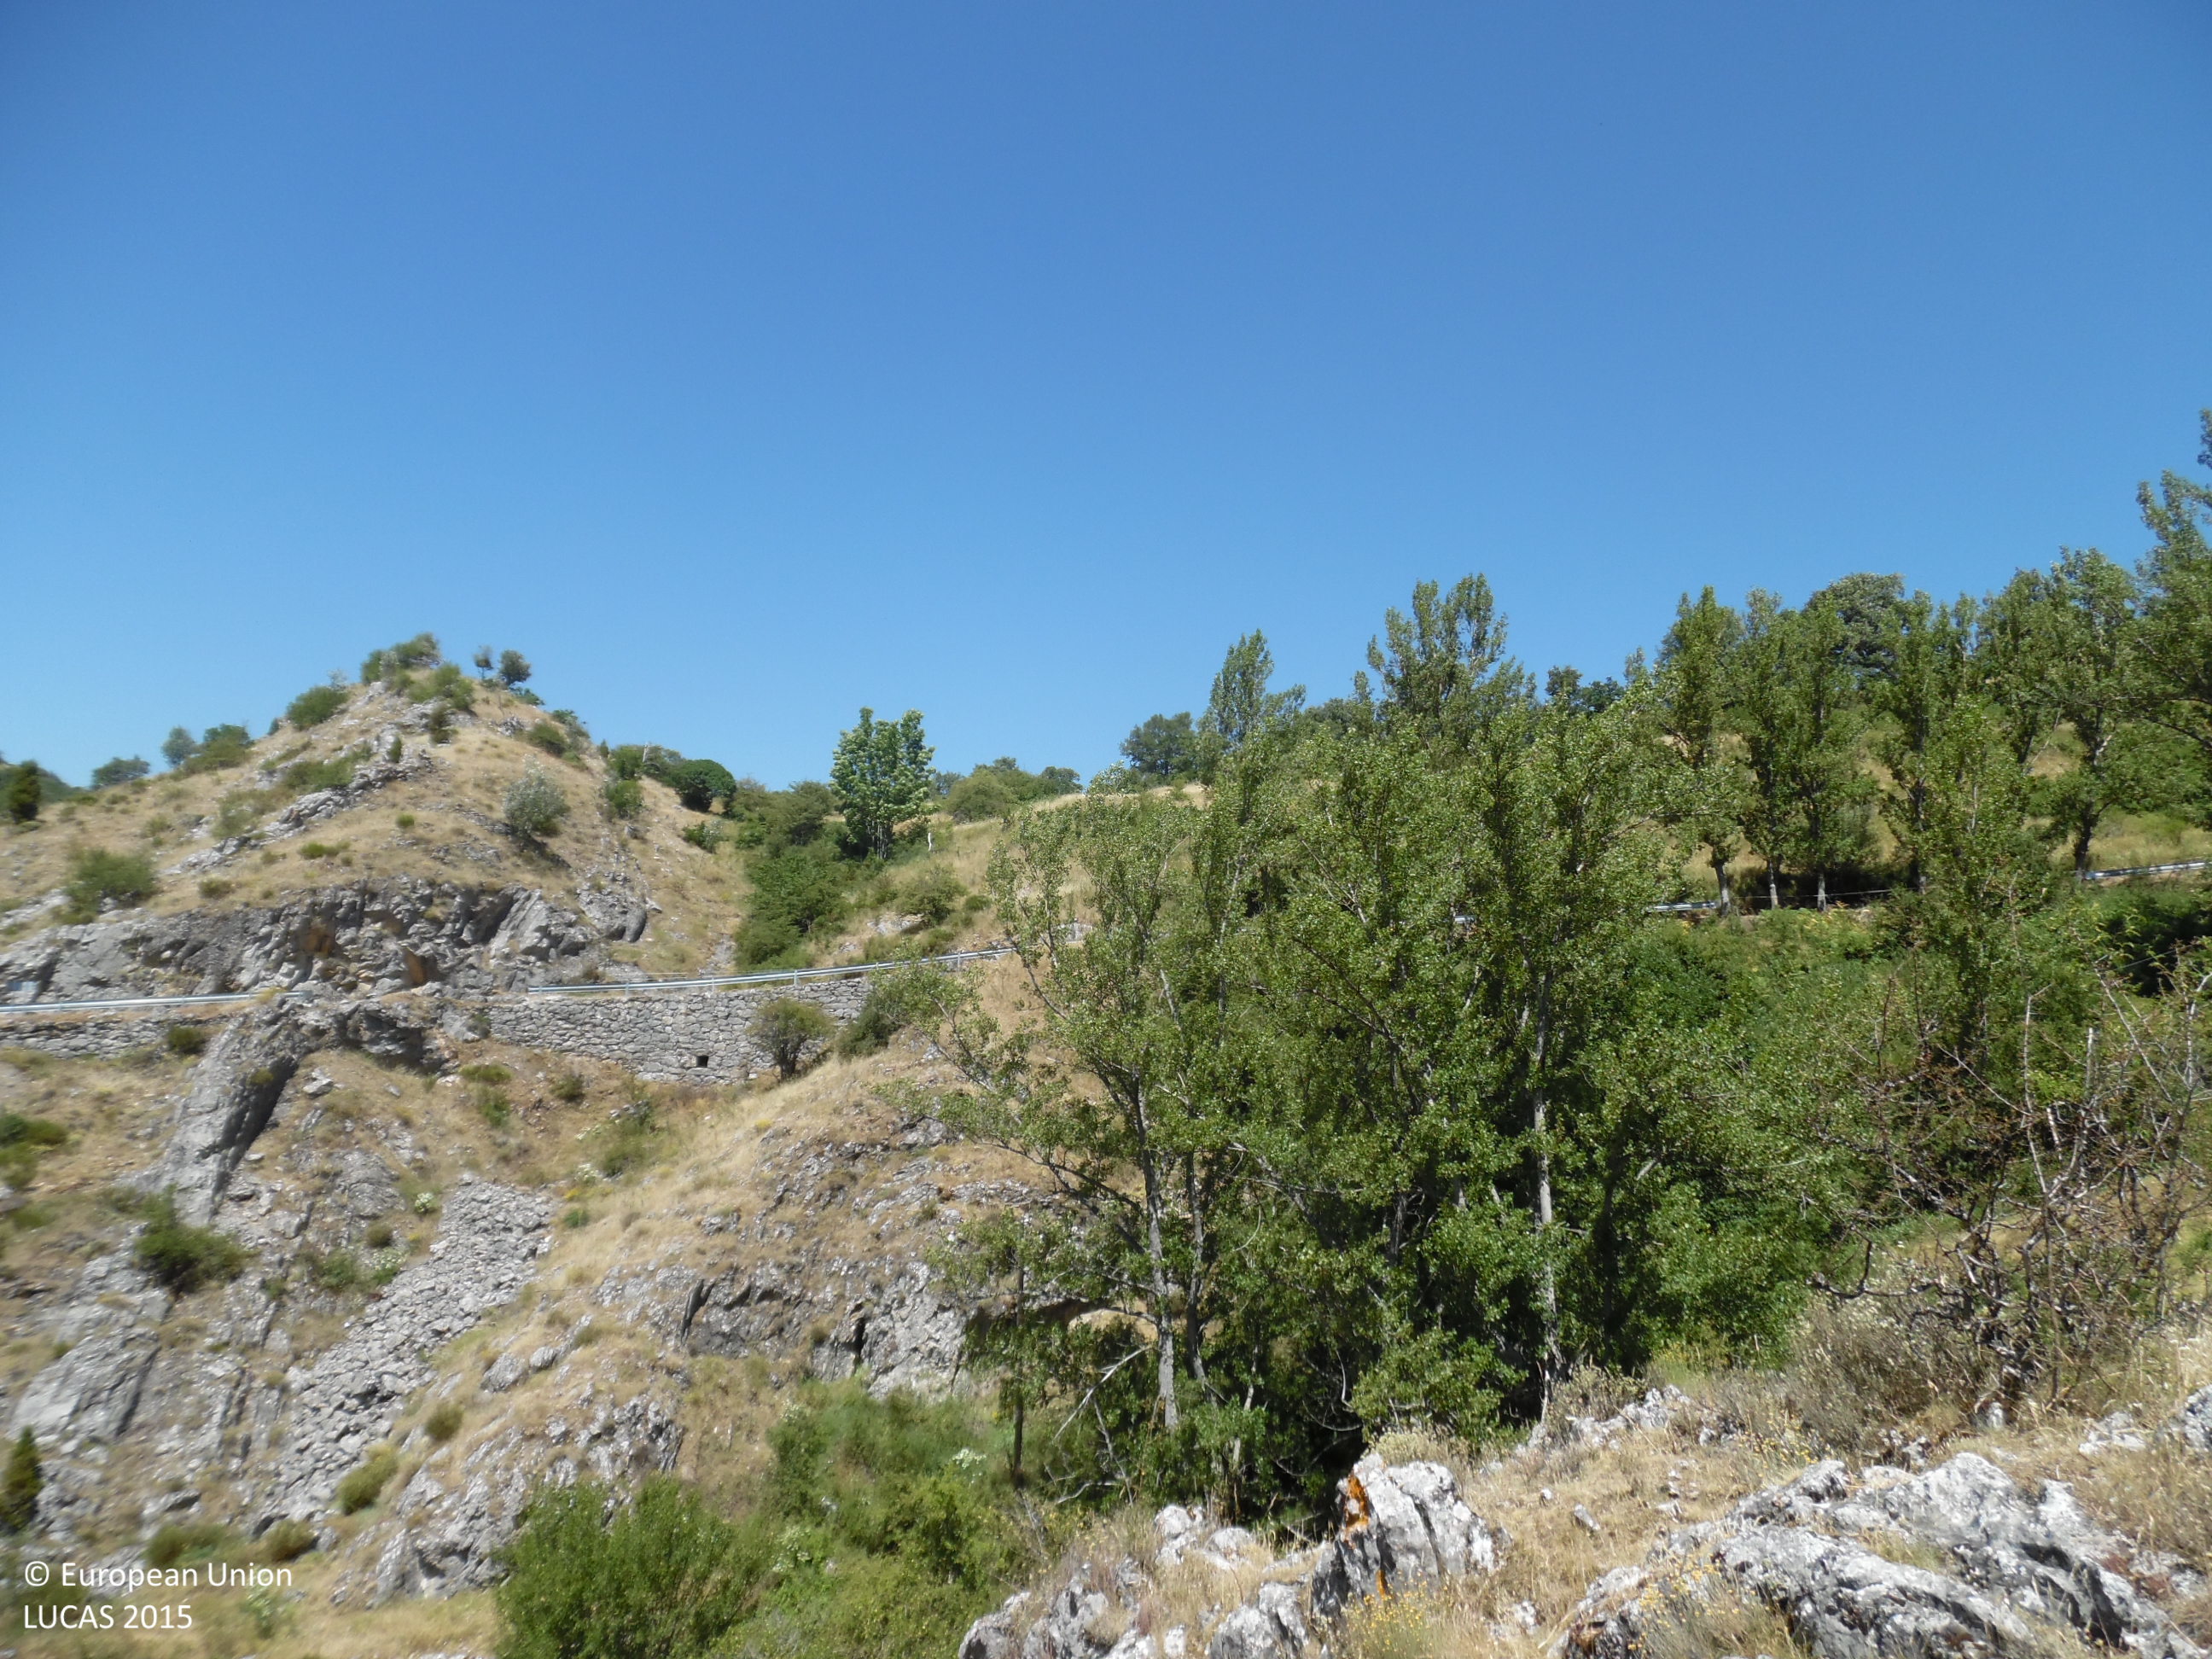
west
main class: Grassland
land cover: Grassland with sparse tree/shrub cover
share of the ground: > 75 %
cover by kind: herbaceous plants 90 %, broadleaved forest trees 5 %, shrubs 5 %
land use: Agriculture (excluding fallow land and kitchen gardens)
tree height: < 5 m
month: July
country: ES
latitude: 42.8834
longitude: -5.7393
